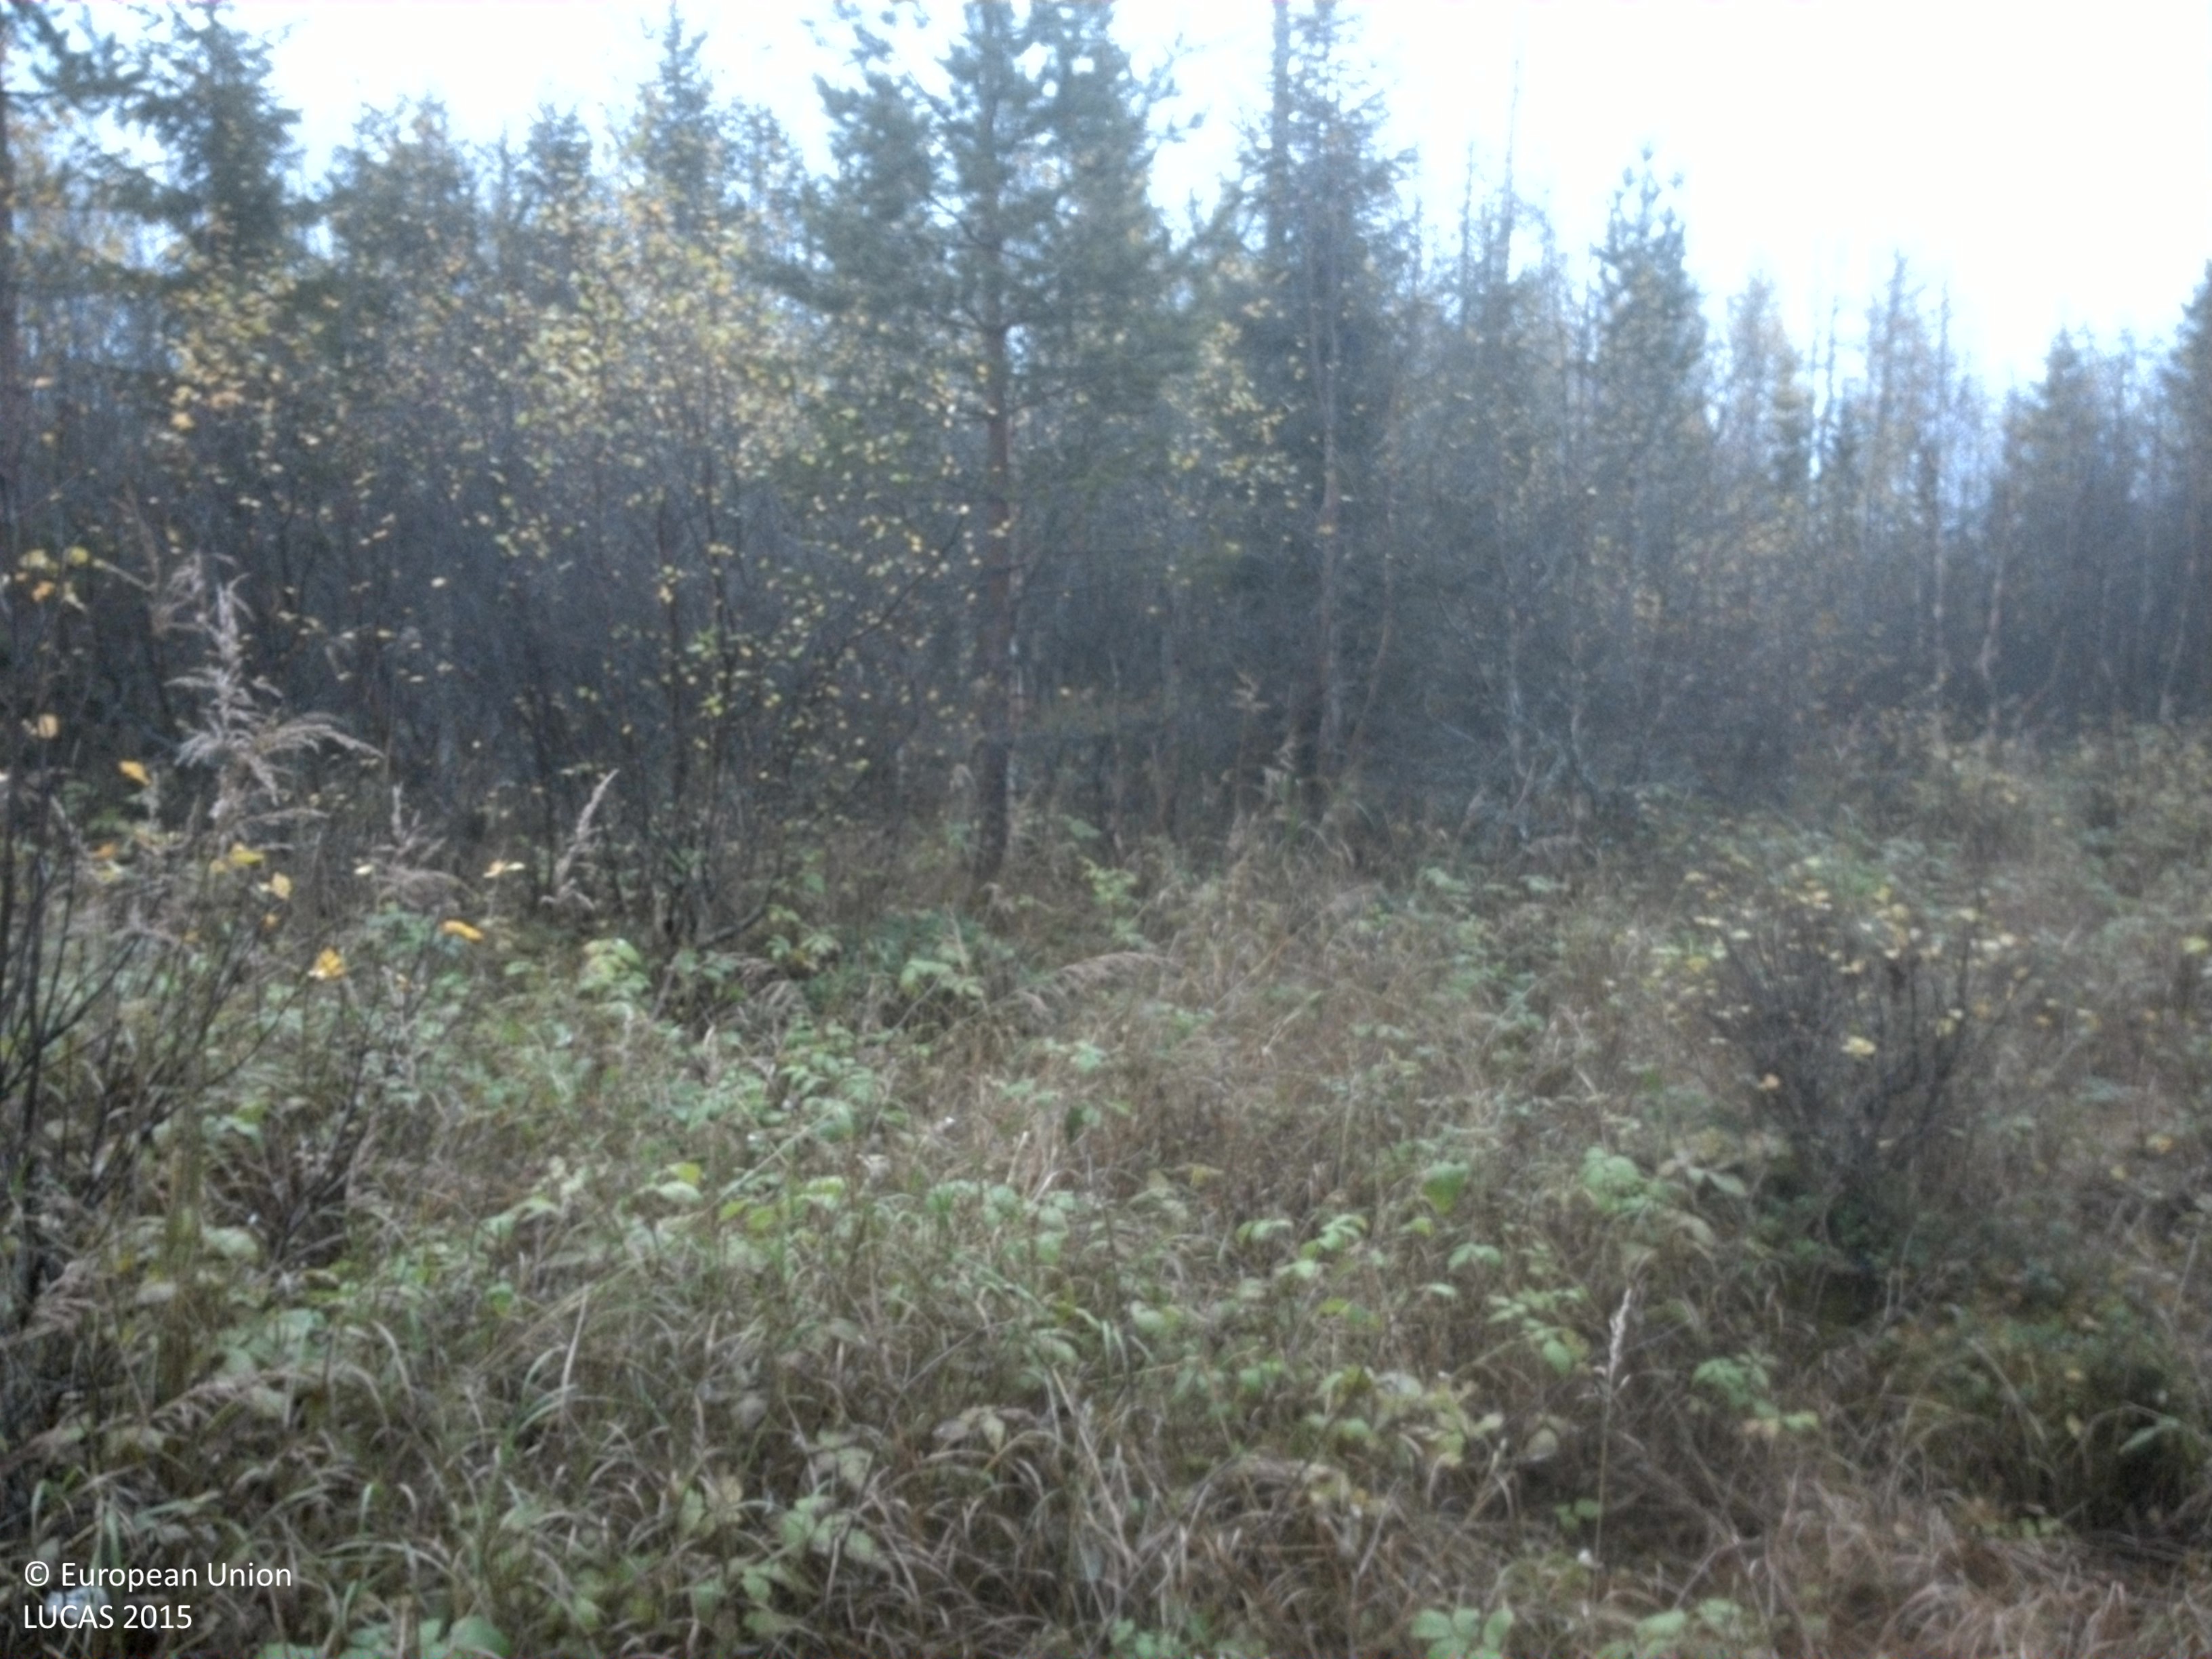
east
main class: Woodland
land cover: Other mixed woodland
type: boreal forest
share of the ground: 25 - 50 %
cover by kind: herbaceous plants 35 %, coniferous forest trees 25 %, broadleaved forest trees 20 %, shrubs 20 %
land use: Forestry
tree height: < 5 m
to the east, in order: Other mixed woodland; Grassland with sparse tree/shrub cover; Broadleaved woodland; Other mixed woodland; Spruce dominated coniferous woodland; Other coniferous woodland
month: October
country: SE
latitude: 64.0918
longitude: 19.8437
